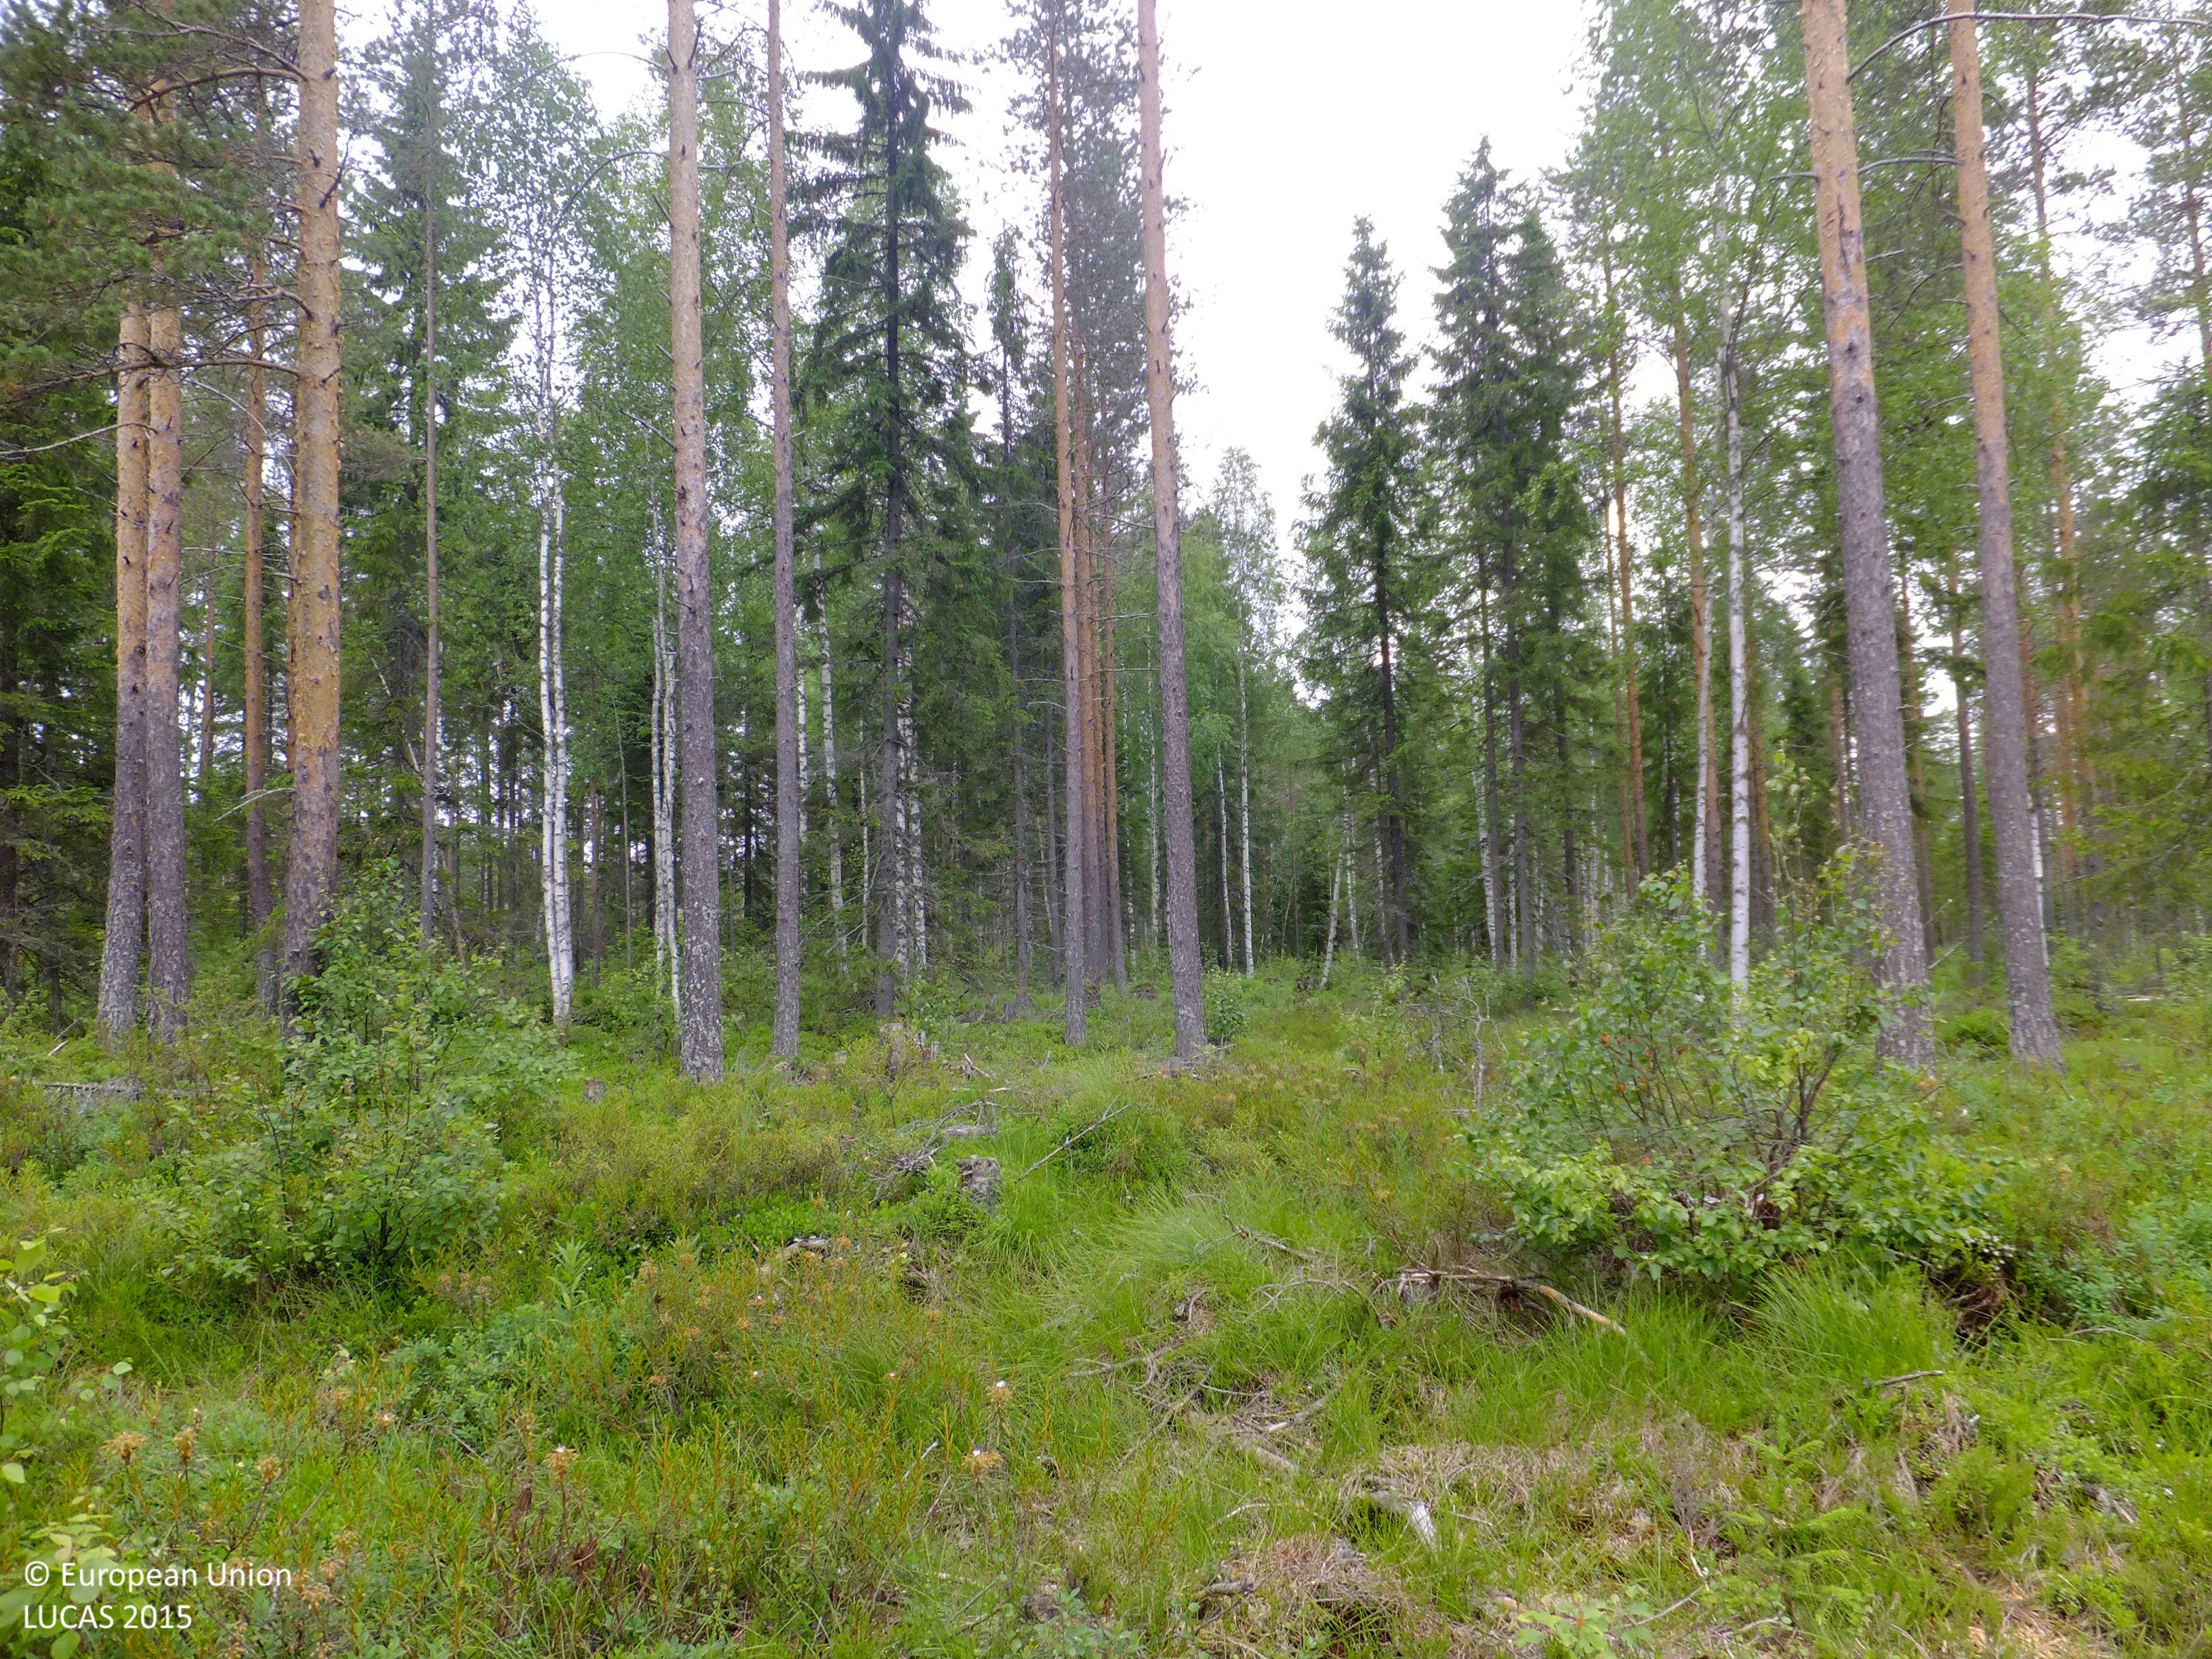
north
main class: Woodland
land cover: Pine dominated mixed woodland
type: boreal forest
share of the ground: 50 - 75 %
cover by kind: coniferous forest trees 40 %, broadleaved forest trees 20 %, shrubs 20 %, lichens and mosses 15 %, herbaceous plants 5 %
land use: Forestry
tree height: > 5 m
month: July
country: FI
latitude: 63.1050
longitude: 24.6509
